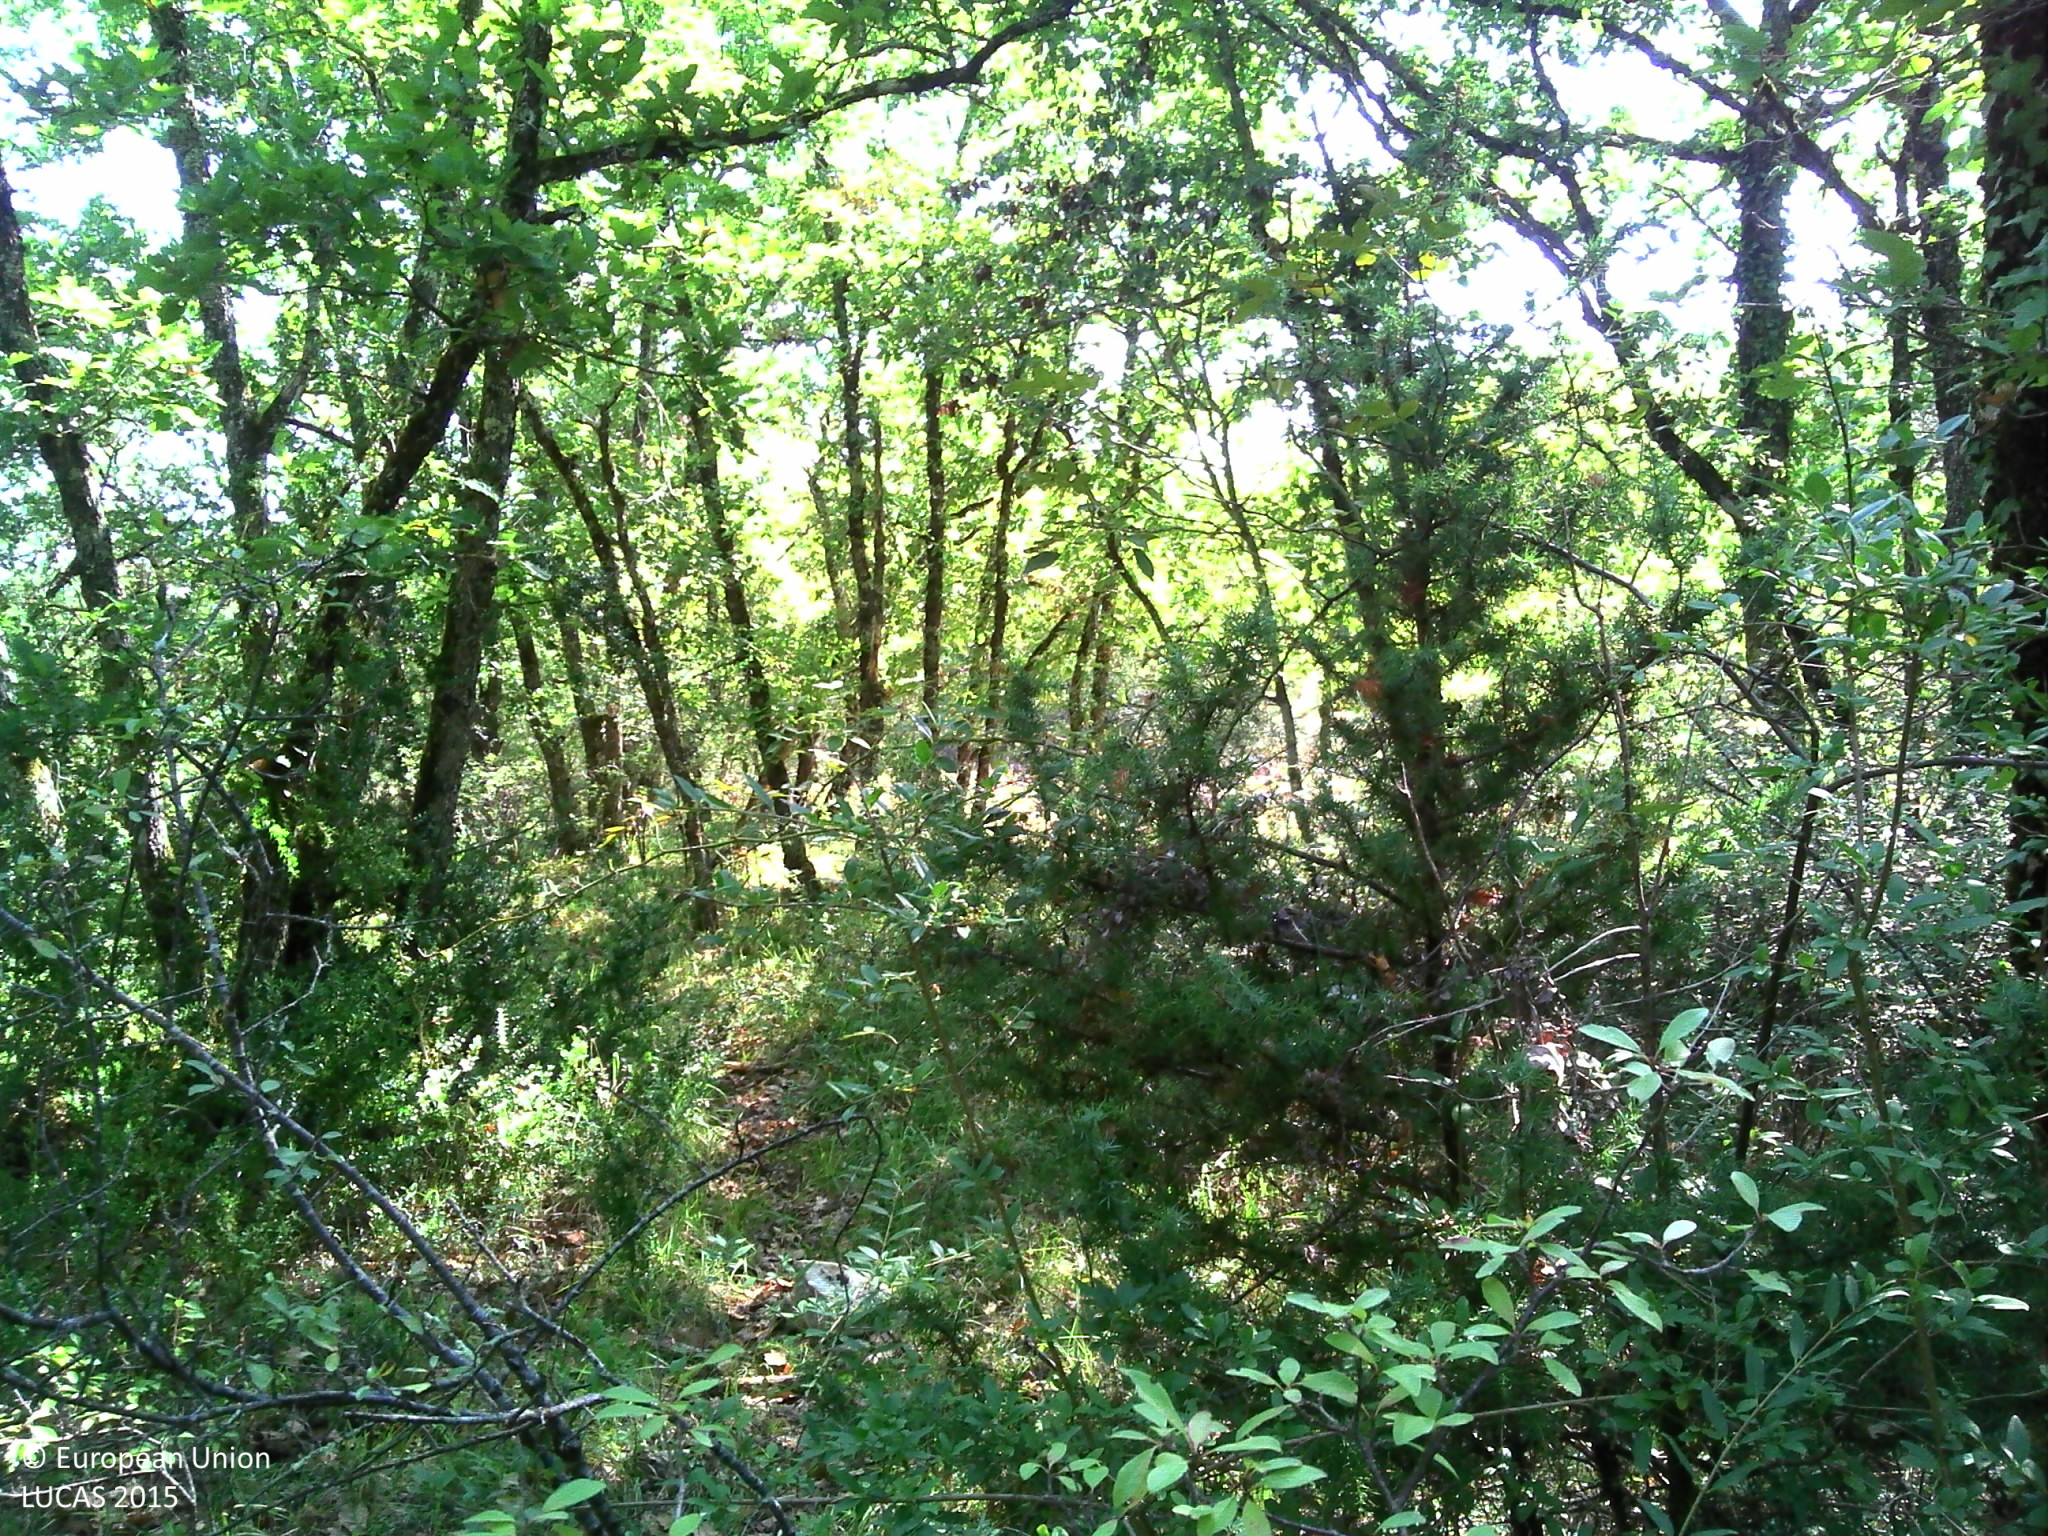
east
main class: Woodland
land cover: Broadleaved woodland
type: mesophytic deciduous forest
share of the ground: > 75 %
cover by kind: broadleaved forest trees 90 %, coniferous forest trees 10 %
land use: Agriculture (excluding fallow land and kitchen gardens)
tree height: > 5 m
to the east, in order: Broadleaved woodland; Grassland with sparse tree/shrub cover; Broadleaved woodland
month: August
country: FR
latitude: 44.2490
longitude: 1.6471
